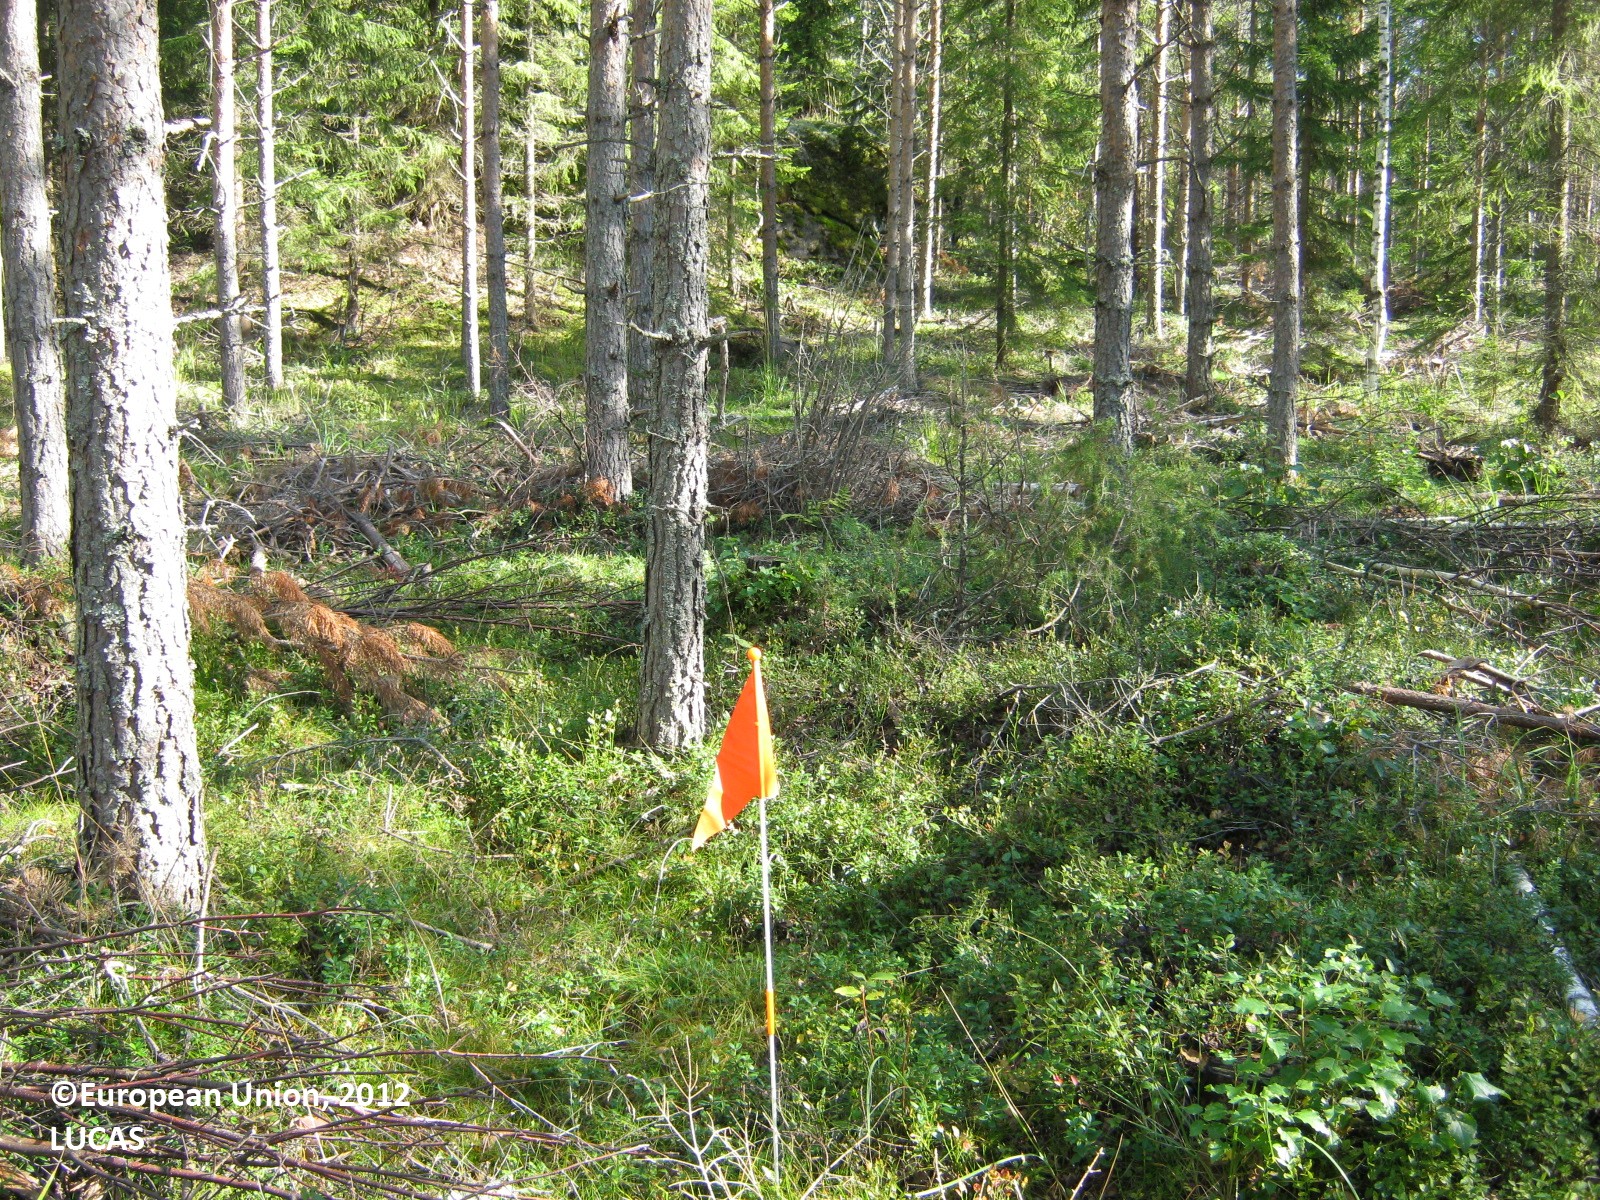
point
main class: Woodland
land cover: Pine dominated coniferous woodland
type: boreal forest
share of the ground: > 75 %
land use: Forestry
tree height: > 5 m
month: September
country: FI
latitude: 60.9535
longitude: 27.8647
